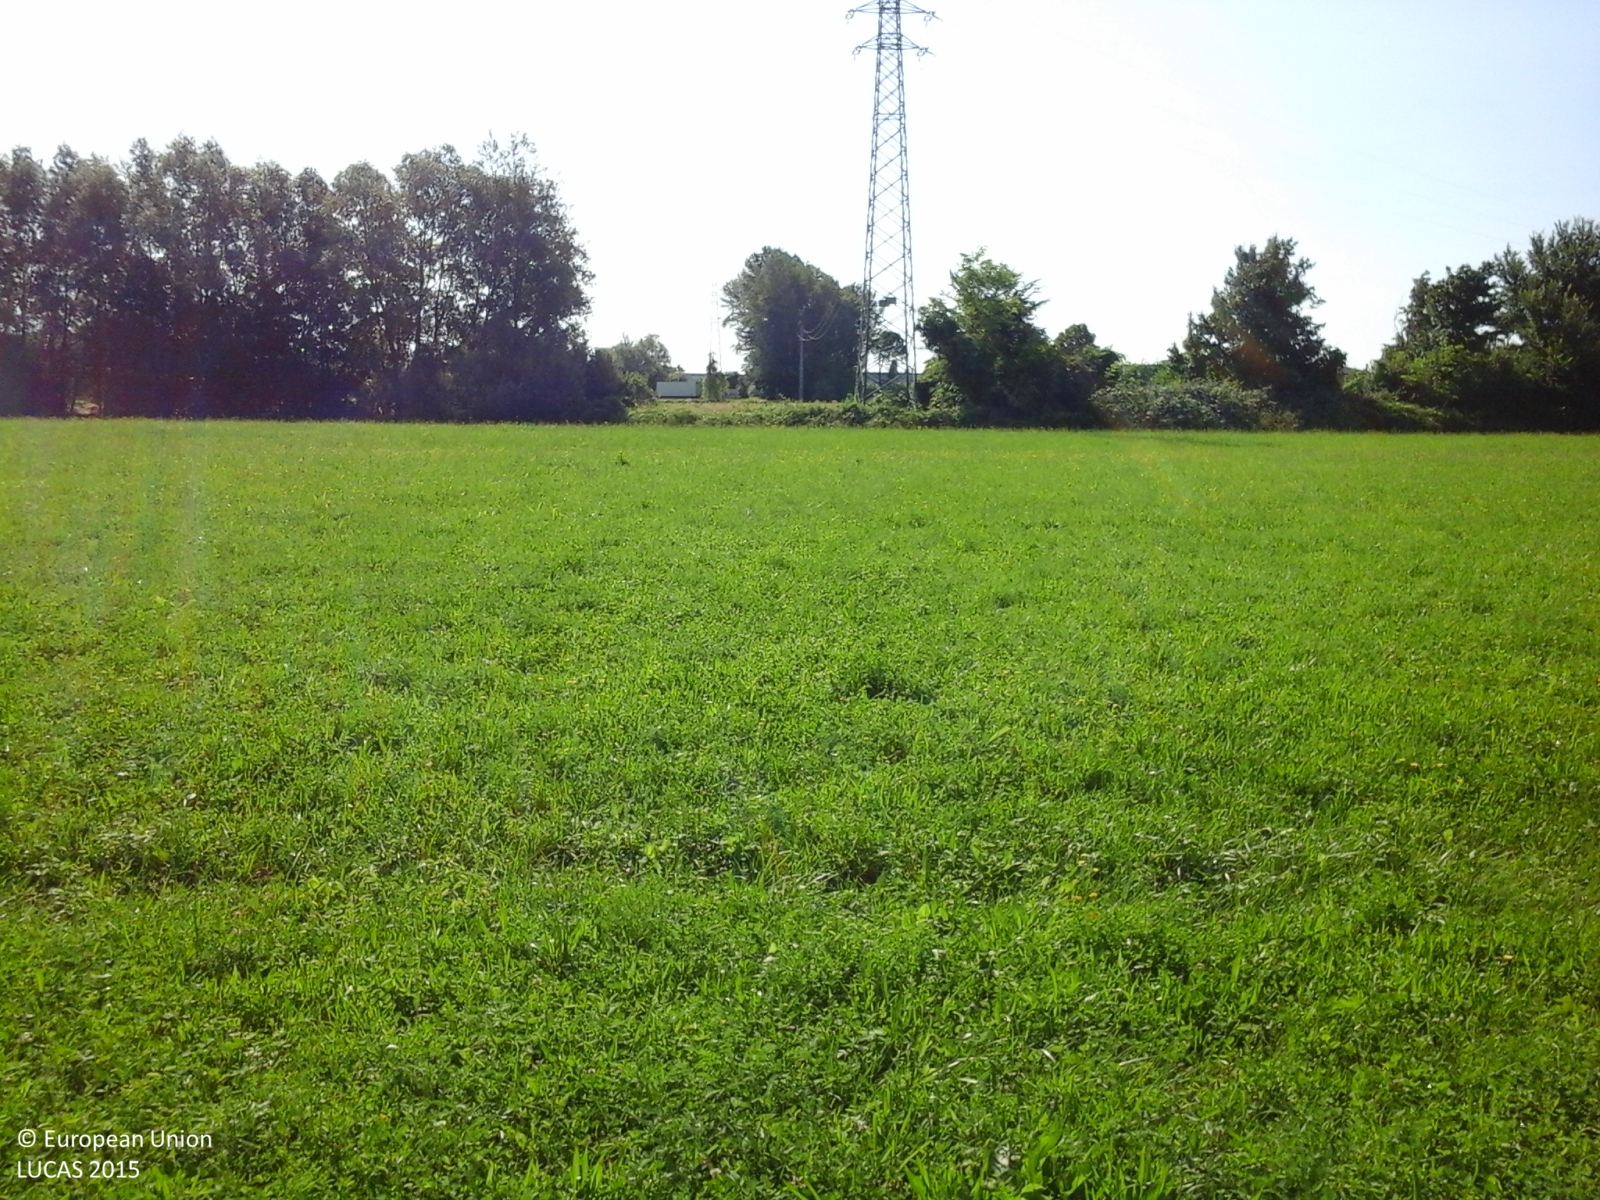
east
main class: Grassland
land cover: Grassland without tree/shrub cover
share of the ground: > 75 %
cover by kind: herbaceous plants 100 %
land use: Agriculture (excluding fallow land and kitchen gardens)
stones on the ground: < 10 %
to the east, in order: Grassland without tree/shrub cover; Abandoned hedges; Ditches and canals; Abandoned hedges; Grassland without tree/shrub cover; Common wheat; Ditches and canals; Grassland without tree/shrub cover
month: June
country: IT
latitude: 45.8753
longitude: 12.3287
